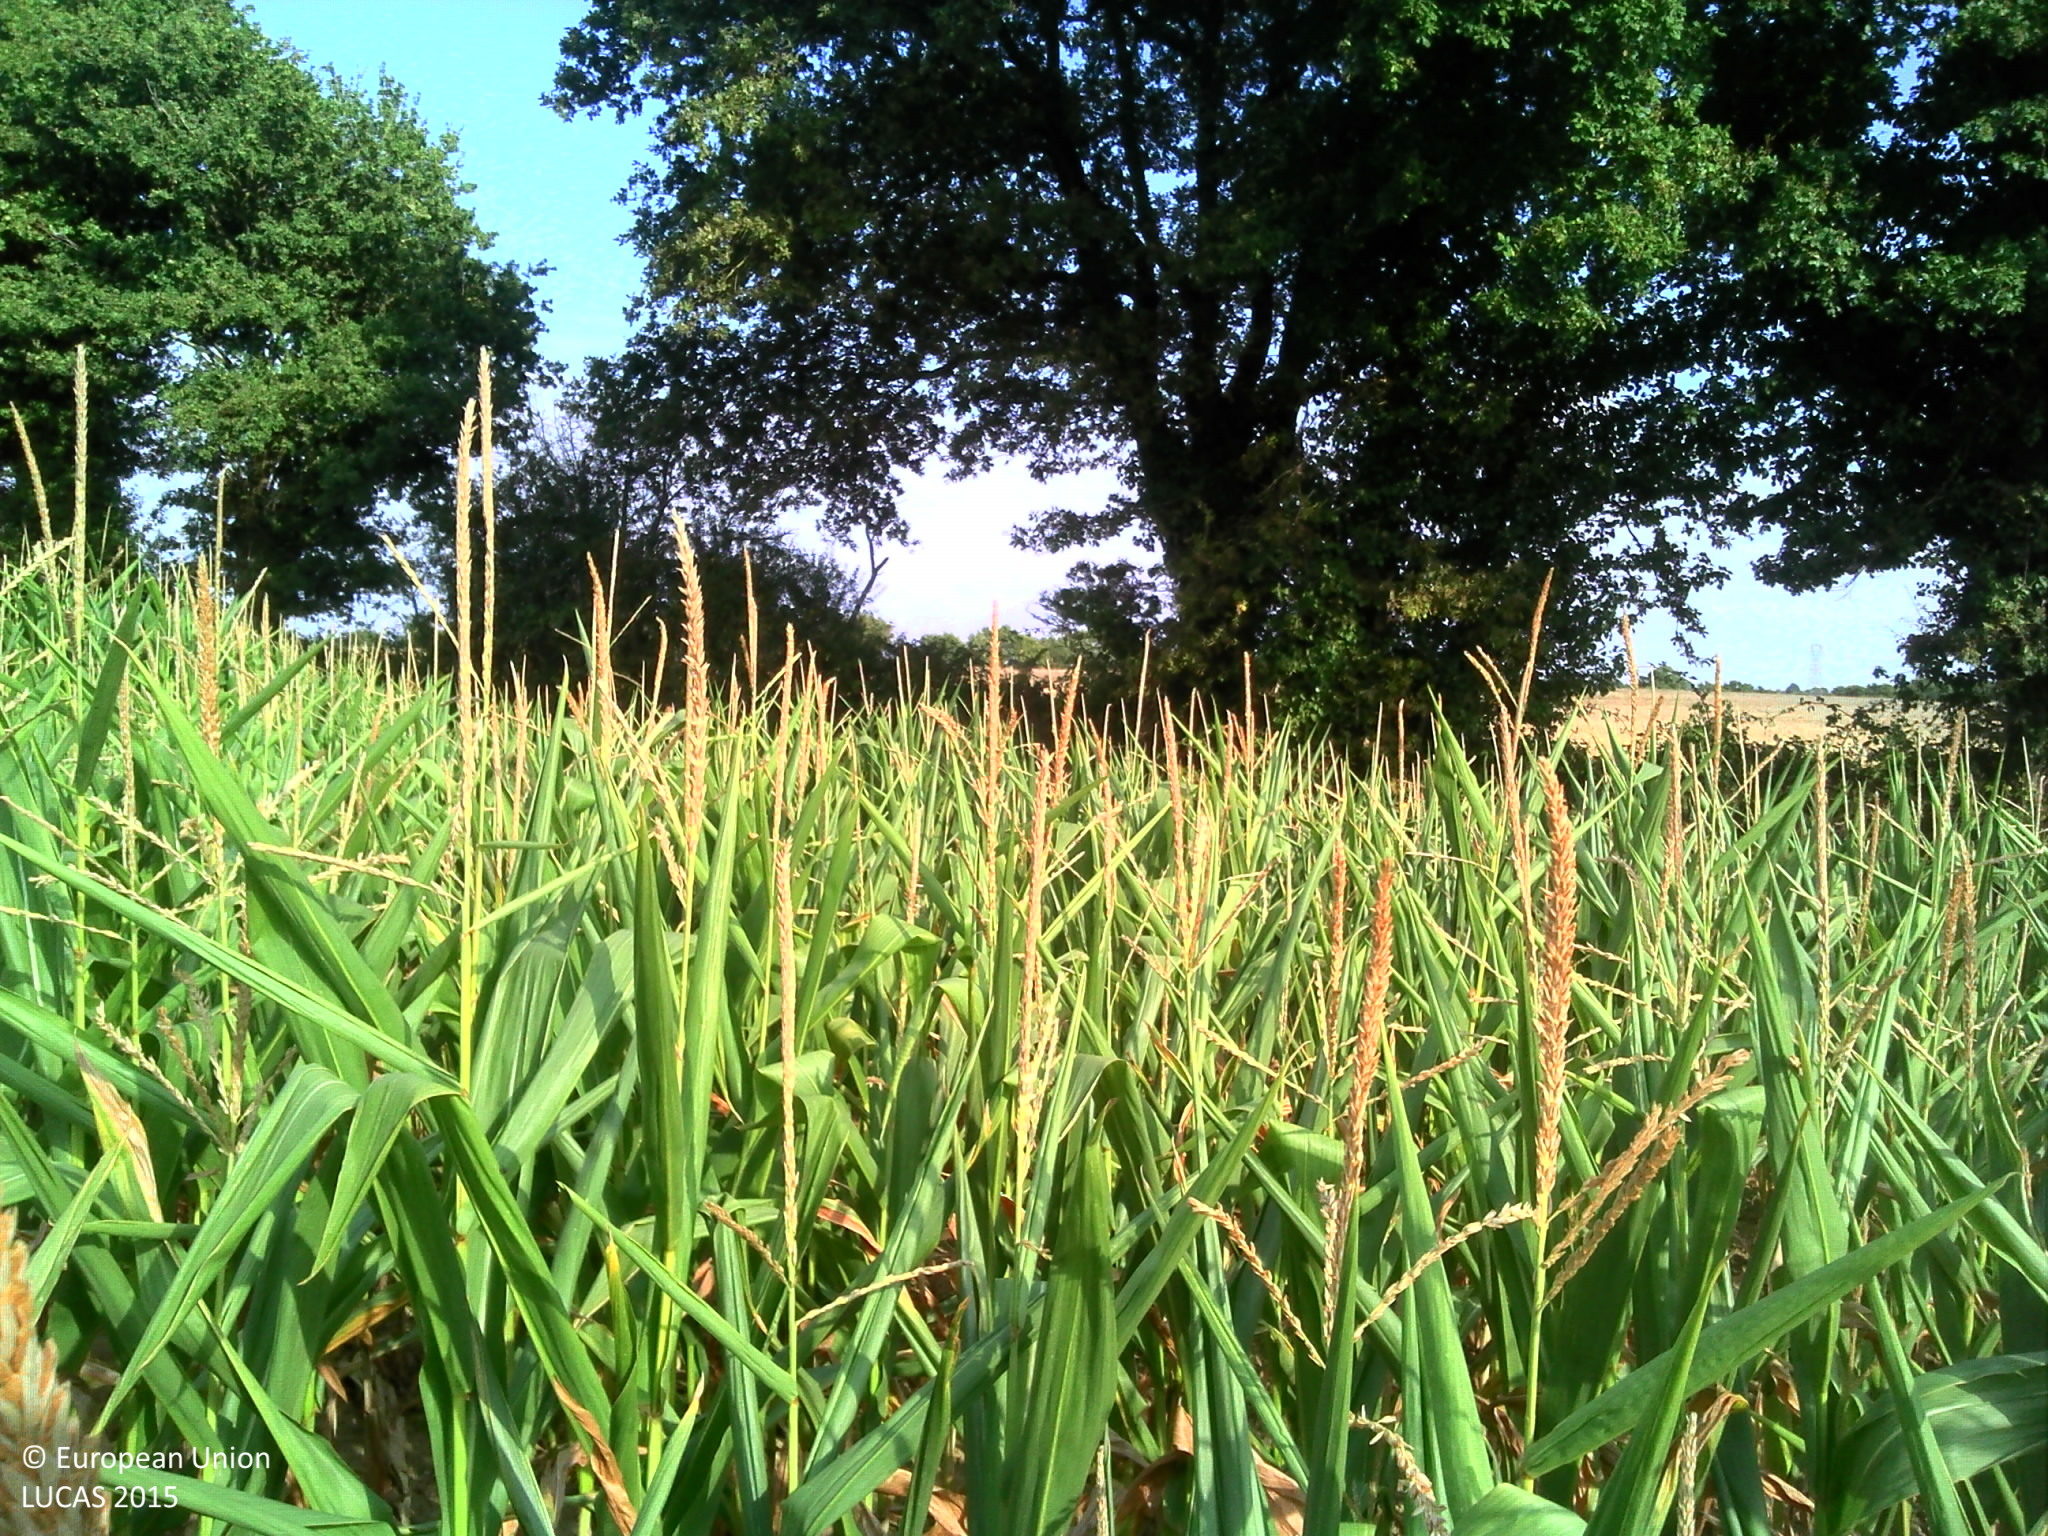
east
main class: Cropland
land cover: Maize
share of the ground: > 75 %
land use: Agriculture (excluding fallow land and kitchen gardens)
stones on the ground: 10 - 25 %
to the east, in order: Maize; Lines of trees; Common wheat
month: August
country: FR
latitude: 46.6577
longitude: -1.3141
